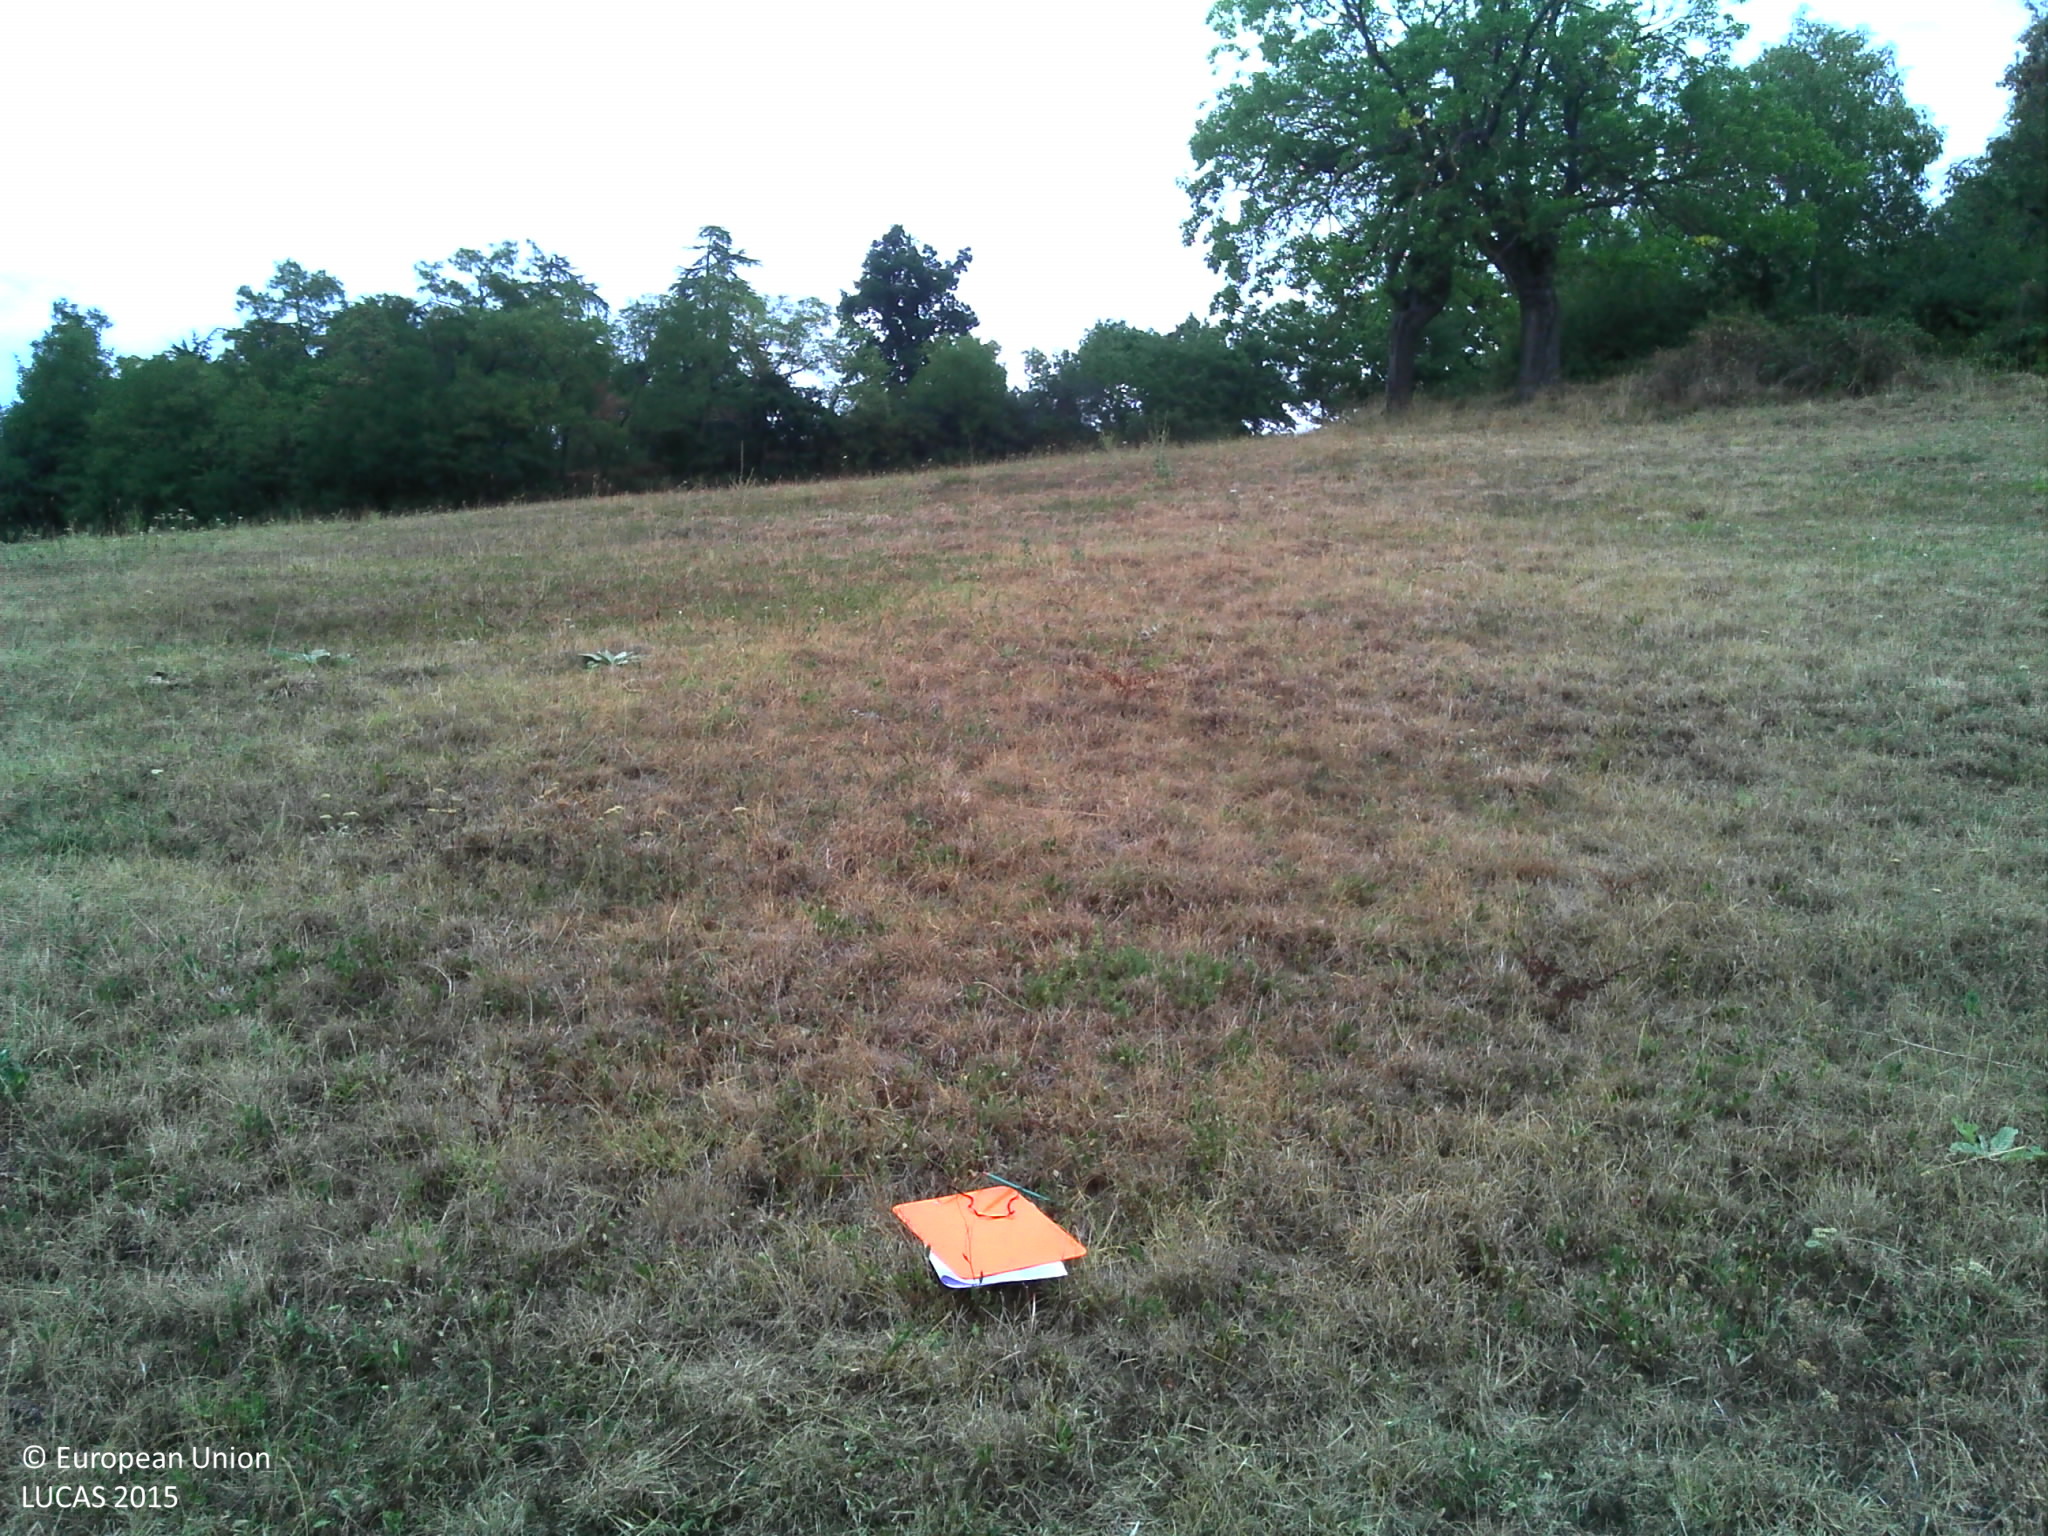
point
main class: Grassland
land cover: Grassland without tree/shrub cover
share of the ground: > 75 %
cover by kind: herbaceous plants 85 %, unconsolidated bare surface 15 %
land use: Agriculture (excluding fallow land and kitchen gardens)
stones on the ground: 10 - 25 %
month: August
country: FR
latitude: 45.2945
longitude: 4.6107
